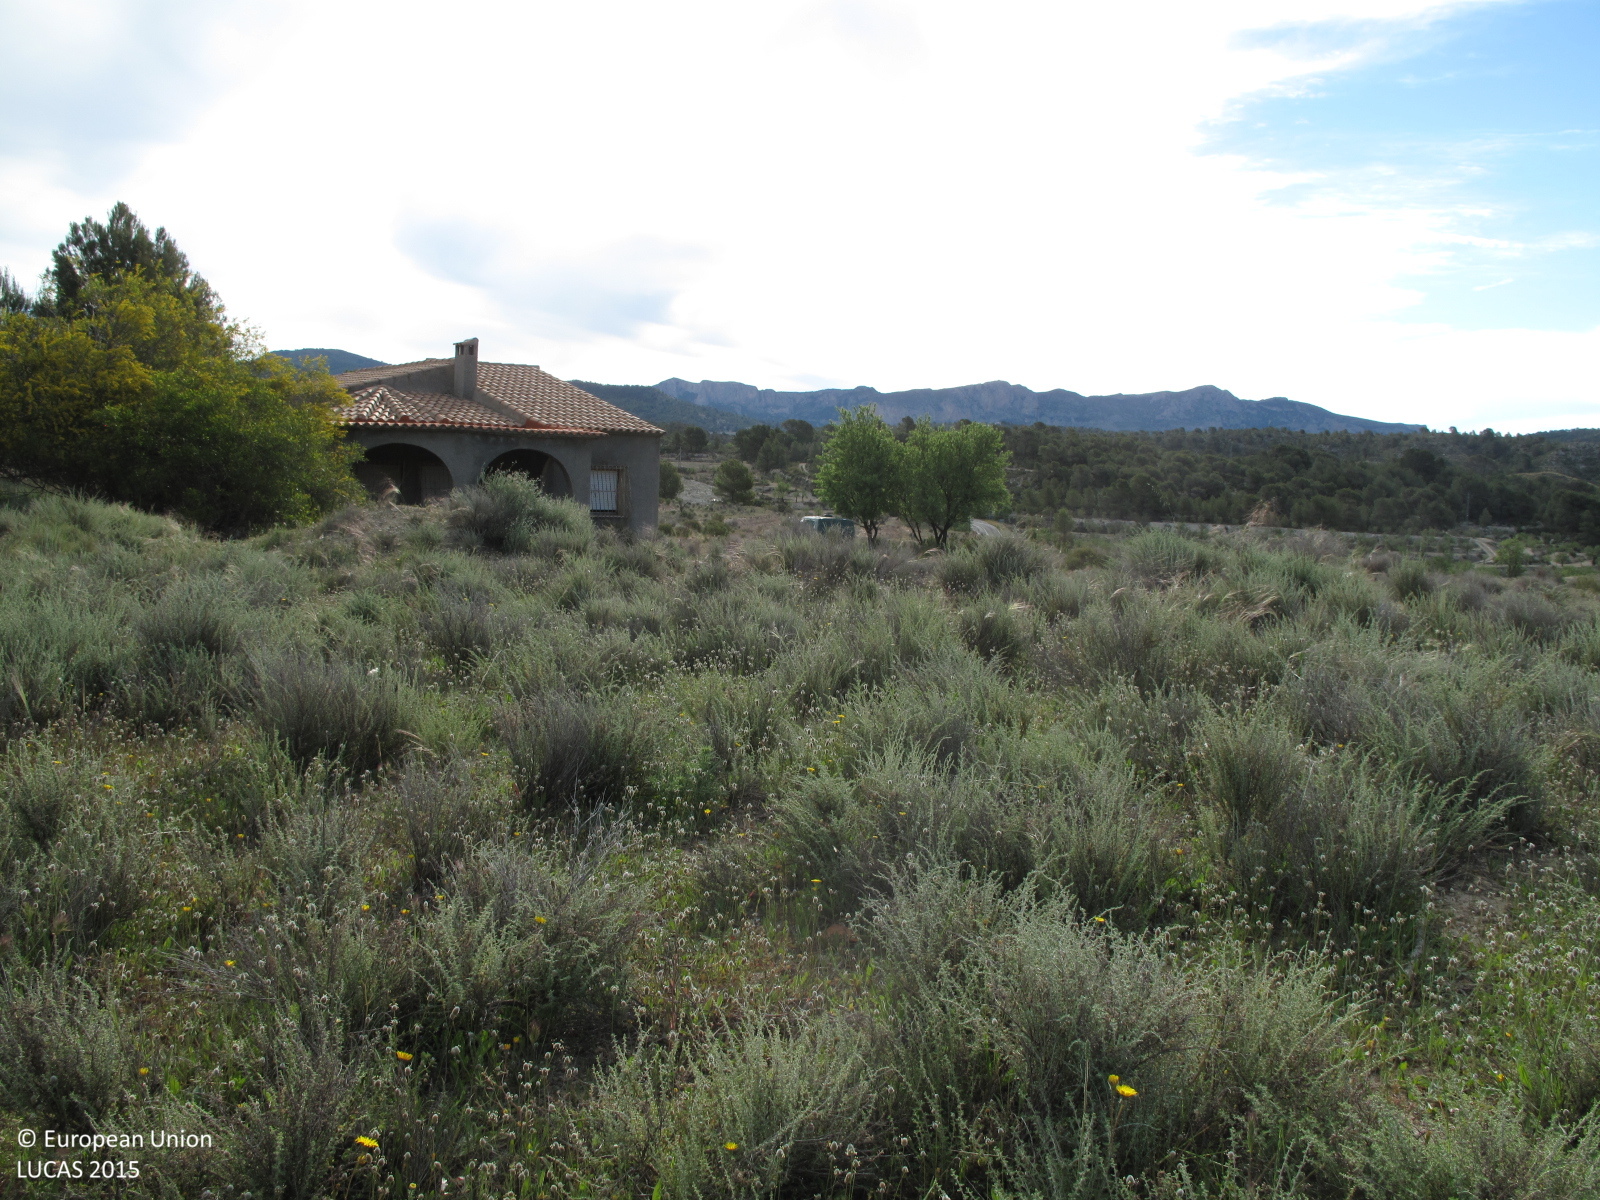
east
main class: Shrubland
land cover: Shrubland without tree cover
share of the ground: 50 - 75 %
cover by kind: shrubs 60 %, herbaceous plants 25 %, consolidated bare surface 15 %
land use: Abandoned areas
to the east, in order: Shrubland without tree cover; Artificial constructions in urban areas; Shrubland without tree cover; Paved roads, cycling and walking lanes; Shrubland with sparse tree cover; Shrubland without tree cover; Shrubland with sparse tree cover; Grassland with sparse tree/shrub cover
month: April
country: ES
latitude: 38.5543
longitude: -0.4874
